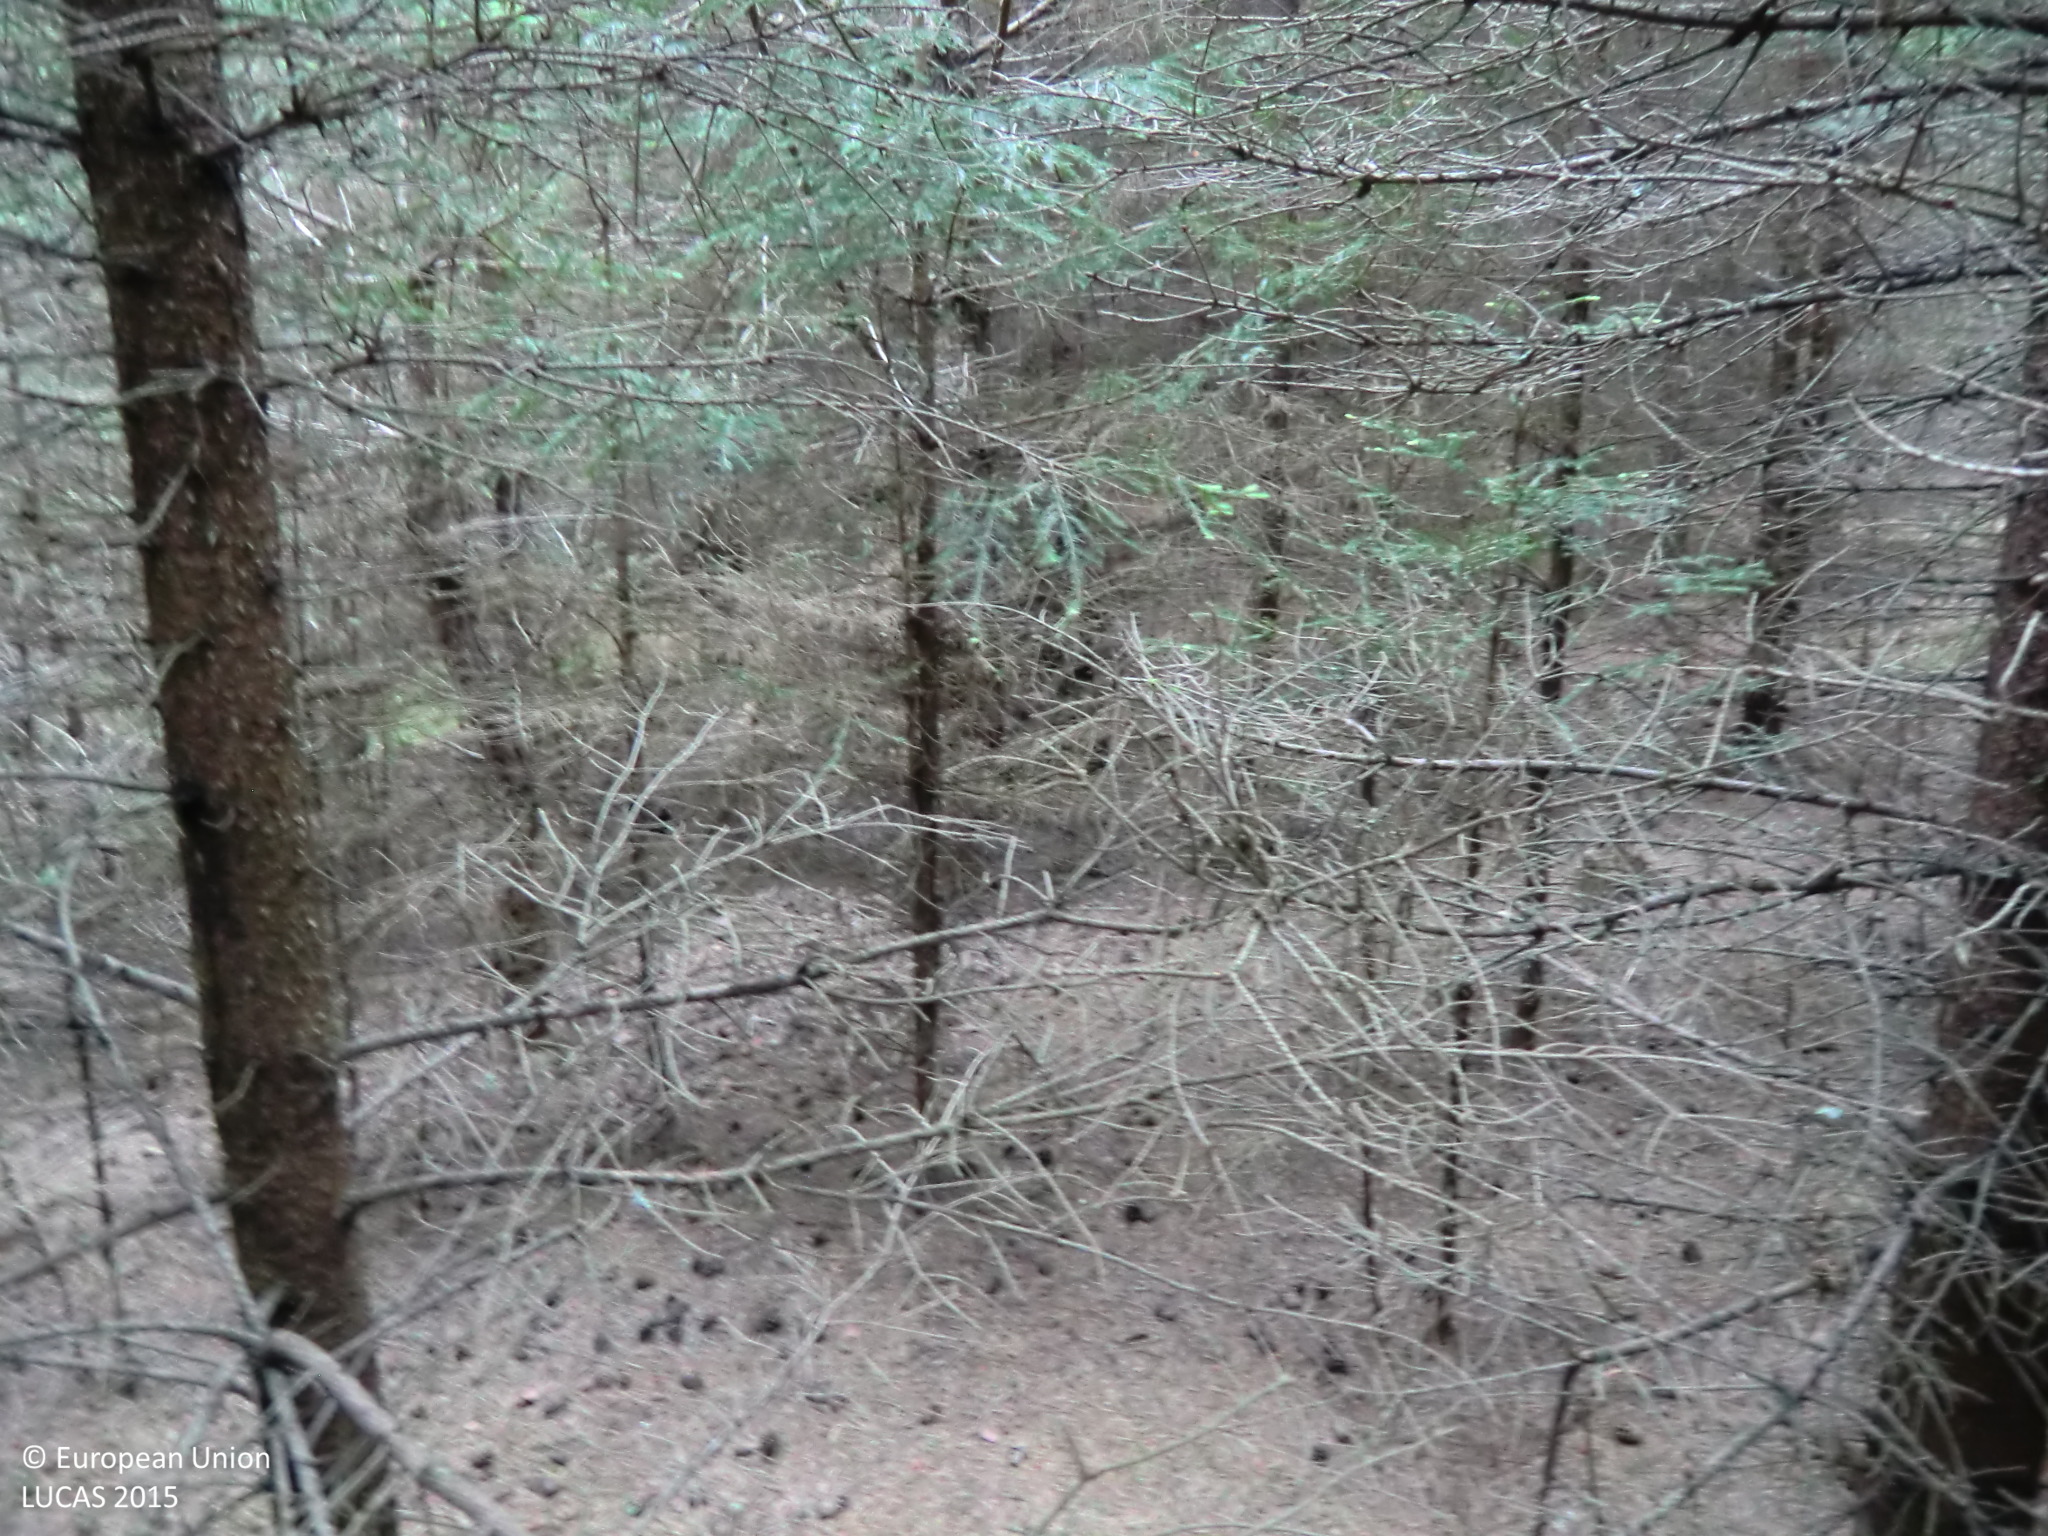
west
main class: Woodland
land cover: Spruce dominated coniferous woodland
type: hemiboreal forest and nemoral coniferous forest and mixed broadleaved-coniferous forest
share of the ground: > 75 %
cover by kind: coniferous forest trees 90 %, unconsolidated bare surface 10 %
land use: Forestry
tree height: > 5 m
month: June
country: AT
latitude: 48.5954
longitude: 15.0322
